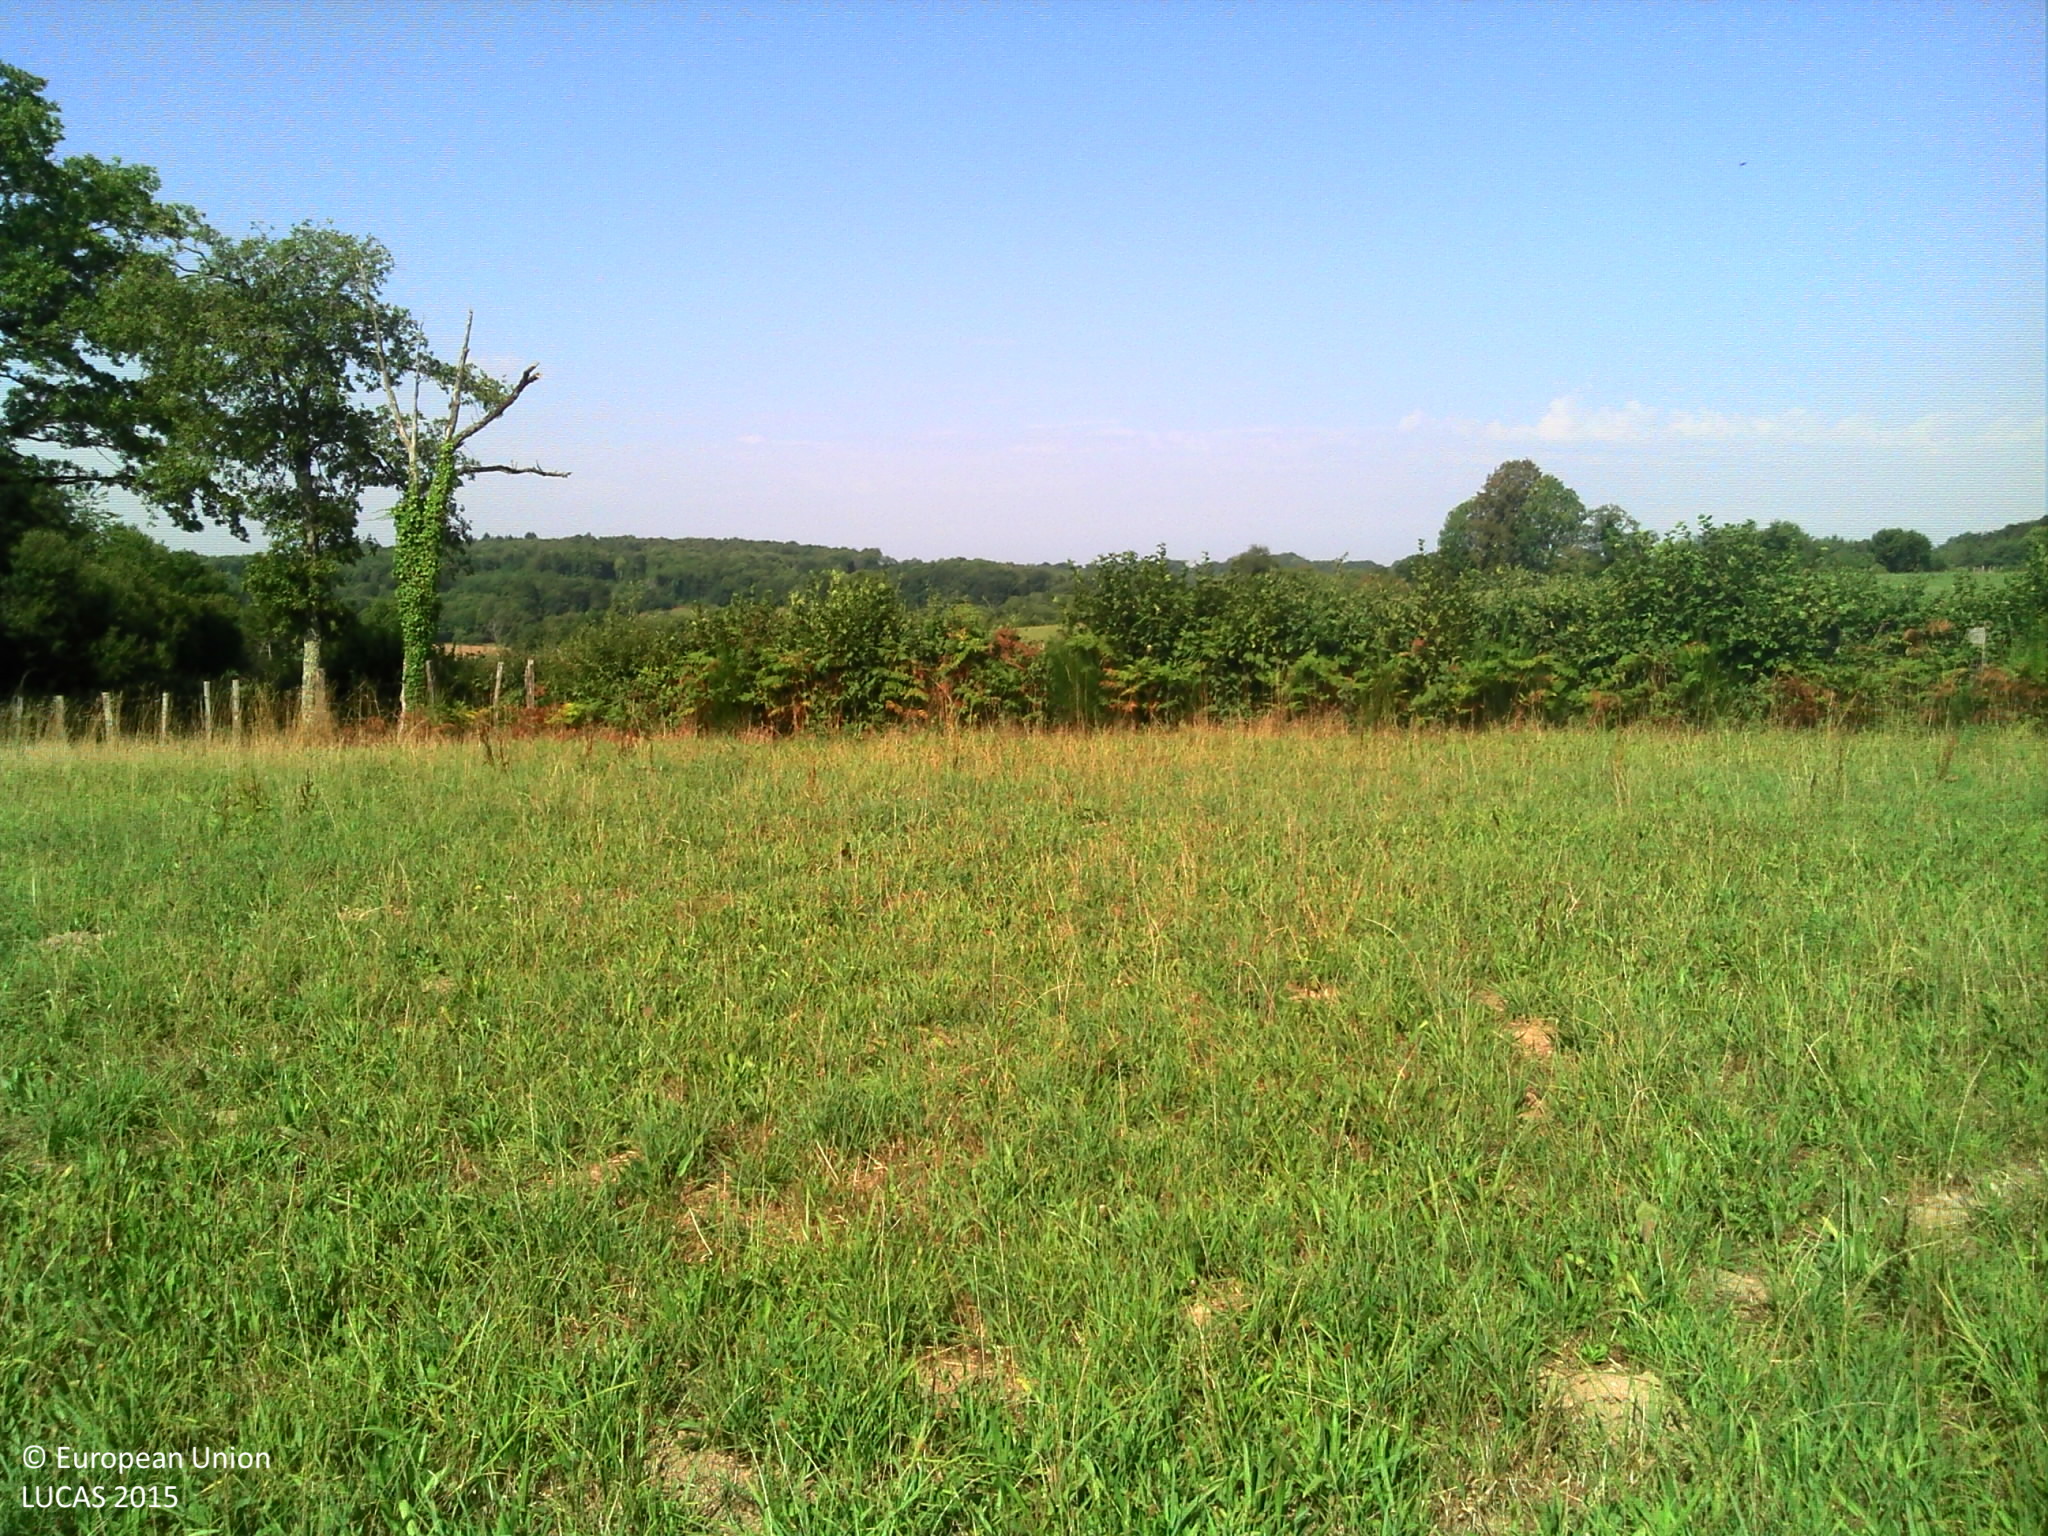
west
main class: Cropland
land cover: Temporary grasslands
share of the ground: > 75 %
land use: Agriculture (excluding fallow land and kitchen gardens)
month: August
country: FR
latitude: 46.2239
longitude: 1.6553
